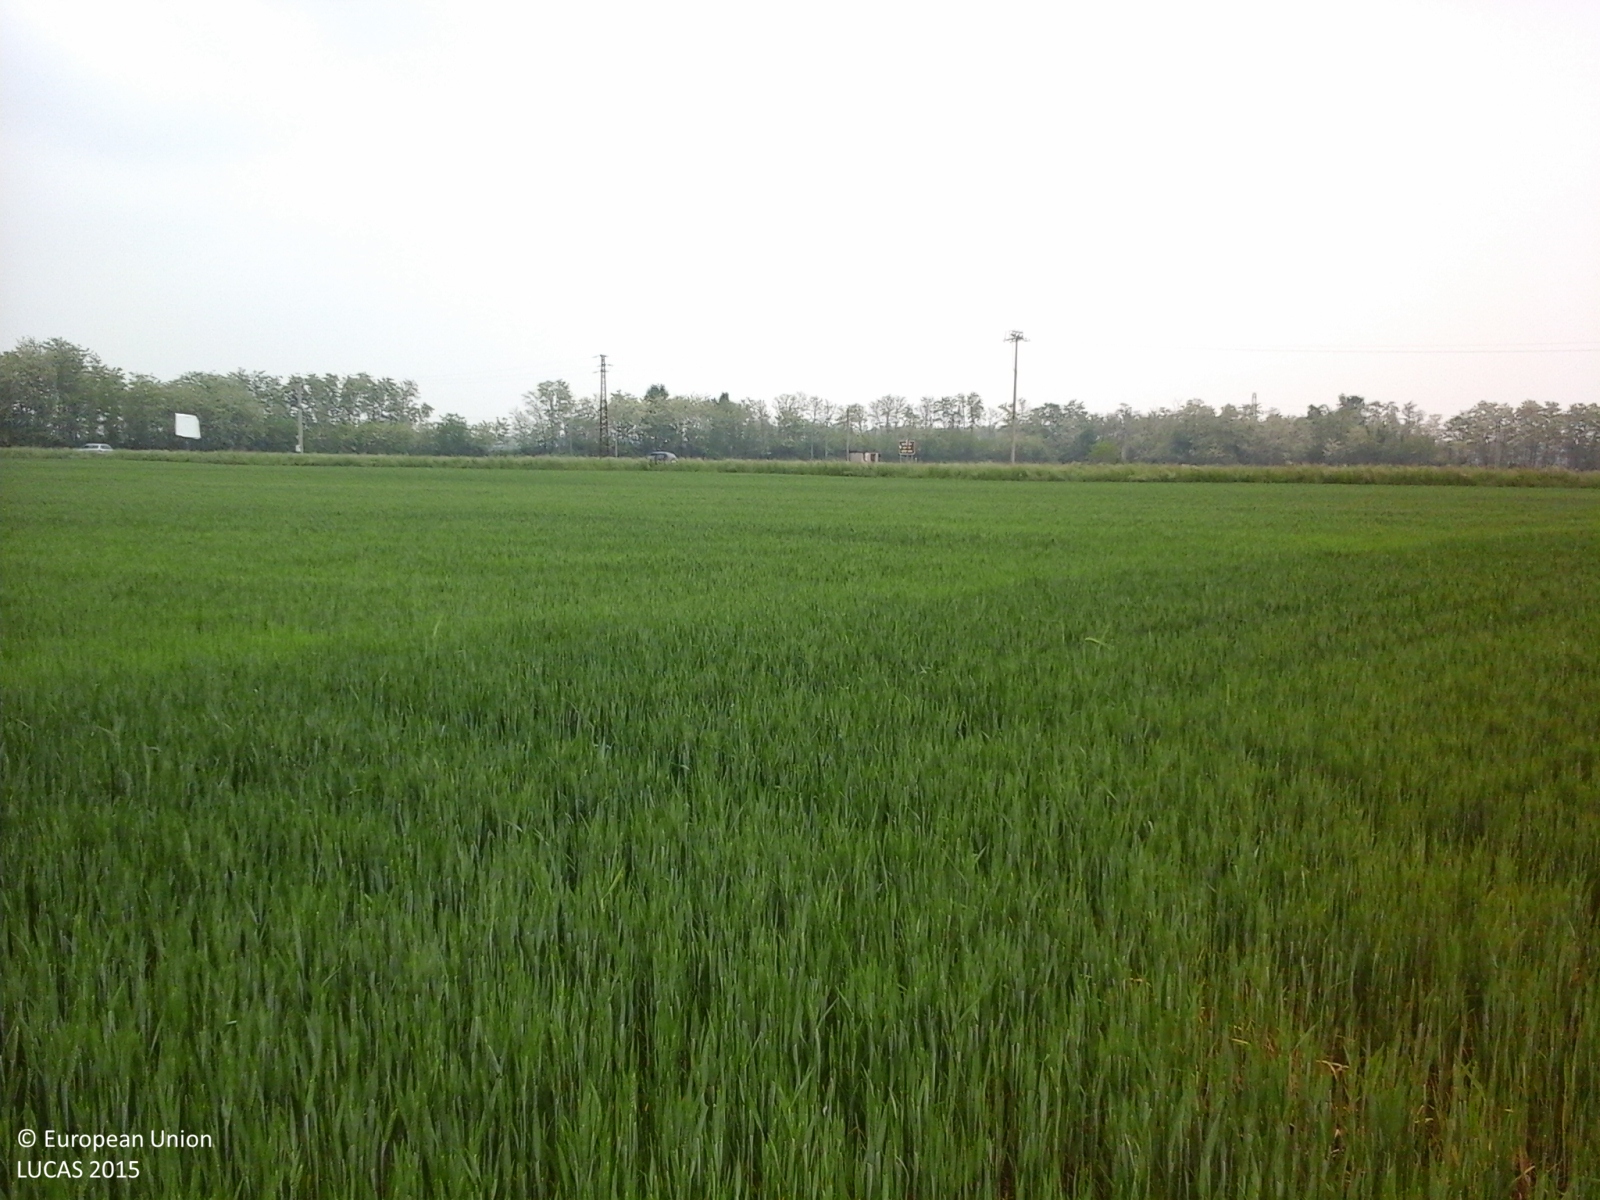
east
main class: Cropland
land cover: Common wheat
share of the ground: > 75 %
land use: Agriculture (excluding fallow land and kitchen gardens)
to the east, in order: Common wheat; Grass margins; Paved roads, cycling and walking lanes; Grass margins; Ditches and canals; Grass margins; Rice; Electric lines; Rice; Other structural elements; Rice
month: May
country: IT
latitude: 45.5309
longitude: 8.5810
